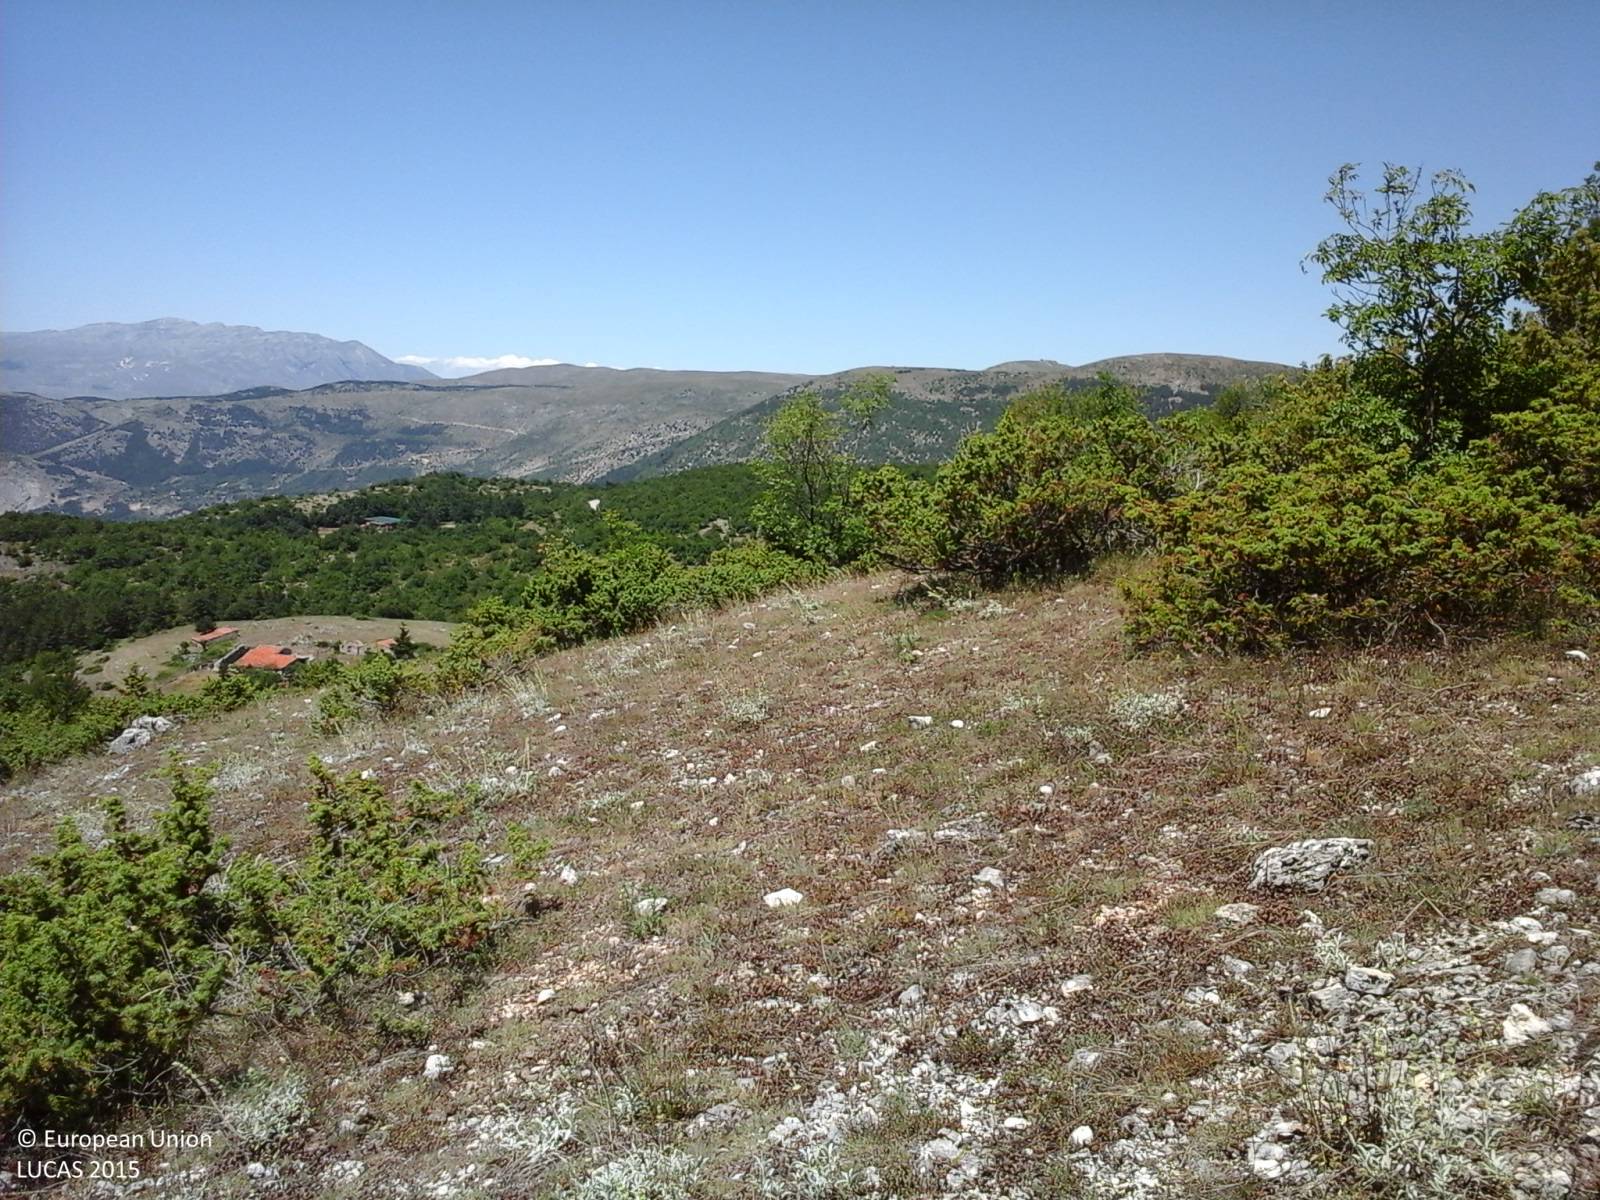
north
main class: Shrubland
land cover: Shrubland with sparse tree cover
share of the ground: > 75 %
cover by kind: herbaceous plants 55 %, shrubs 20 %, unconsolidated bare surface 20 %, broadleaved forest trees 5 %
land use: Agriculture (excluding fallow land and kitchen gardens)
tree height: < 5 m
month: June
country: IT
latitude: 41.9169
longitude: 13.7128
